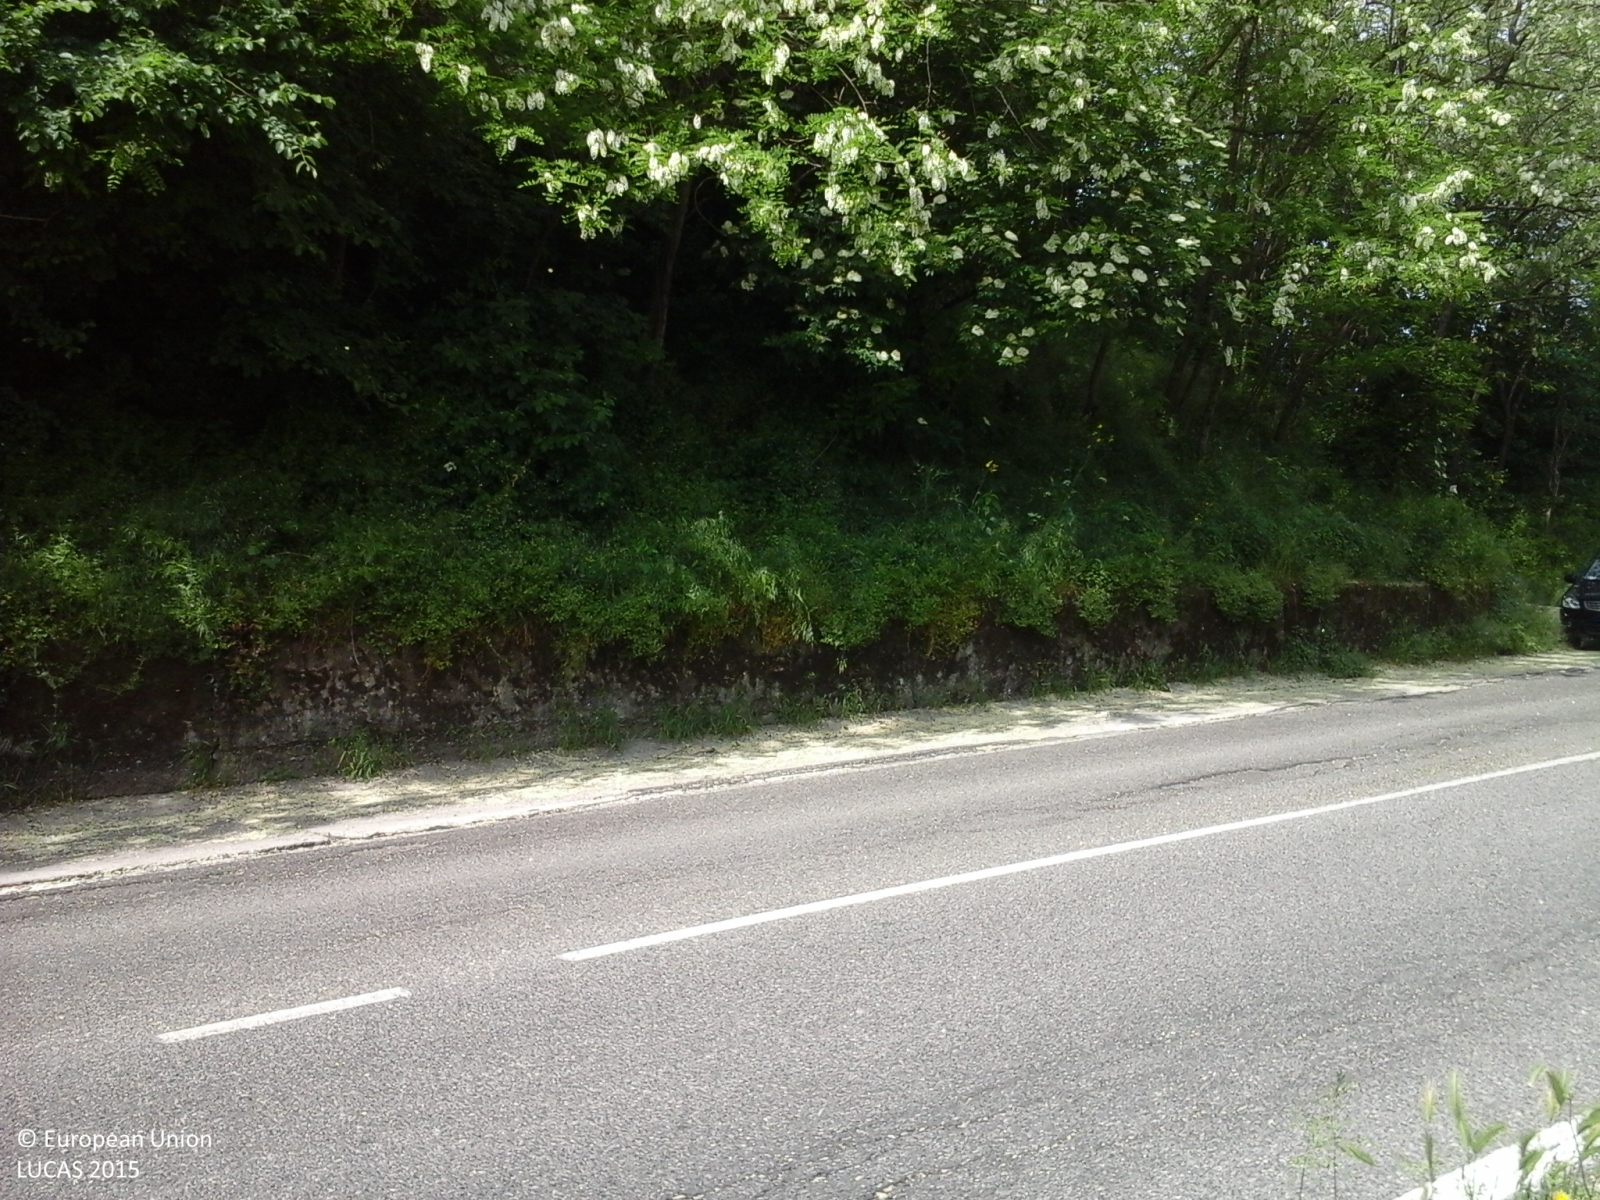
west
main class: Woodland
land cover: Broadleaved woodland
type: exotic forest
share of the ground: > 75 %
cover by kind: broadleaved forest trees 100 %
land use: Forestry
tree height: > 5 m
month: May
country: IT
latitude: 45.0695
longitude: 9.3028
